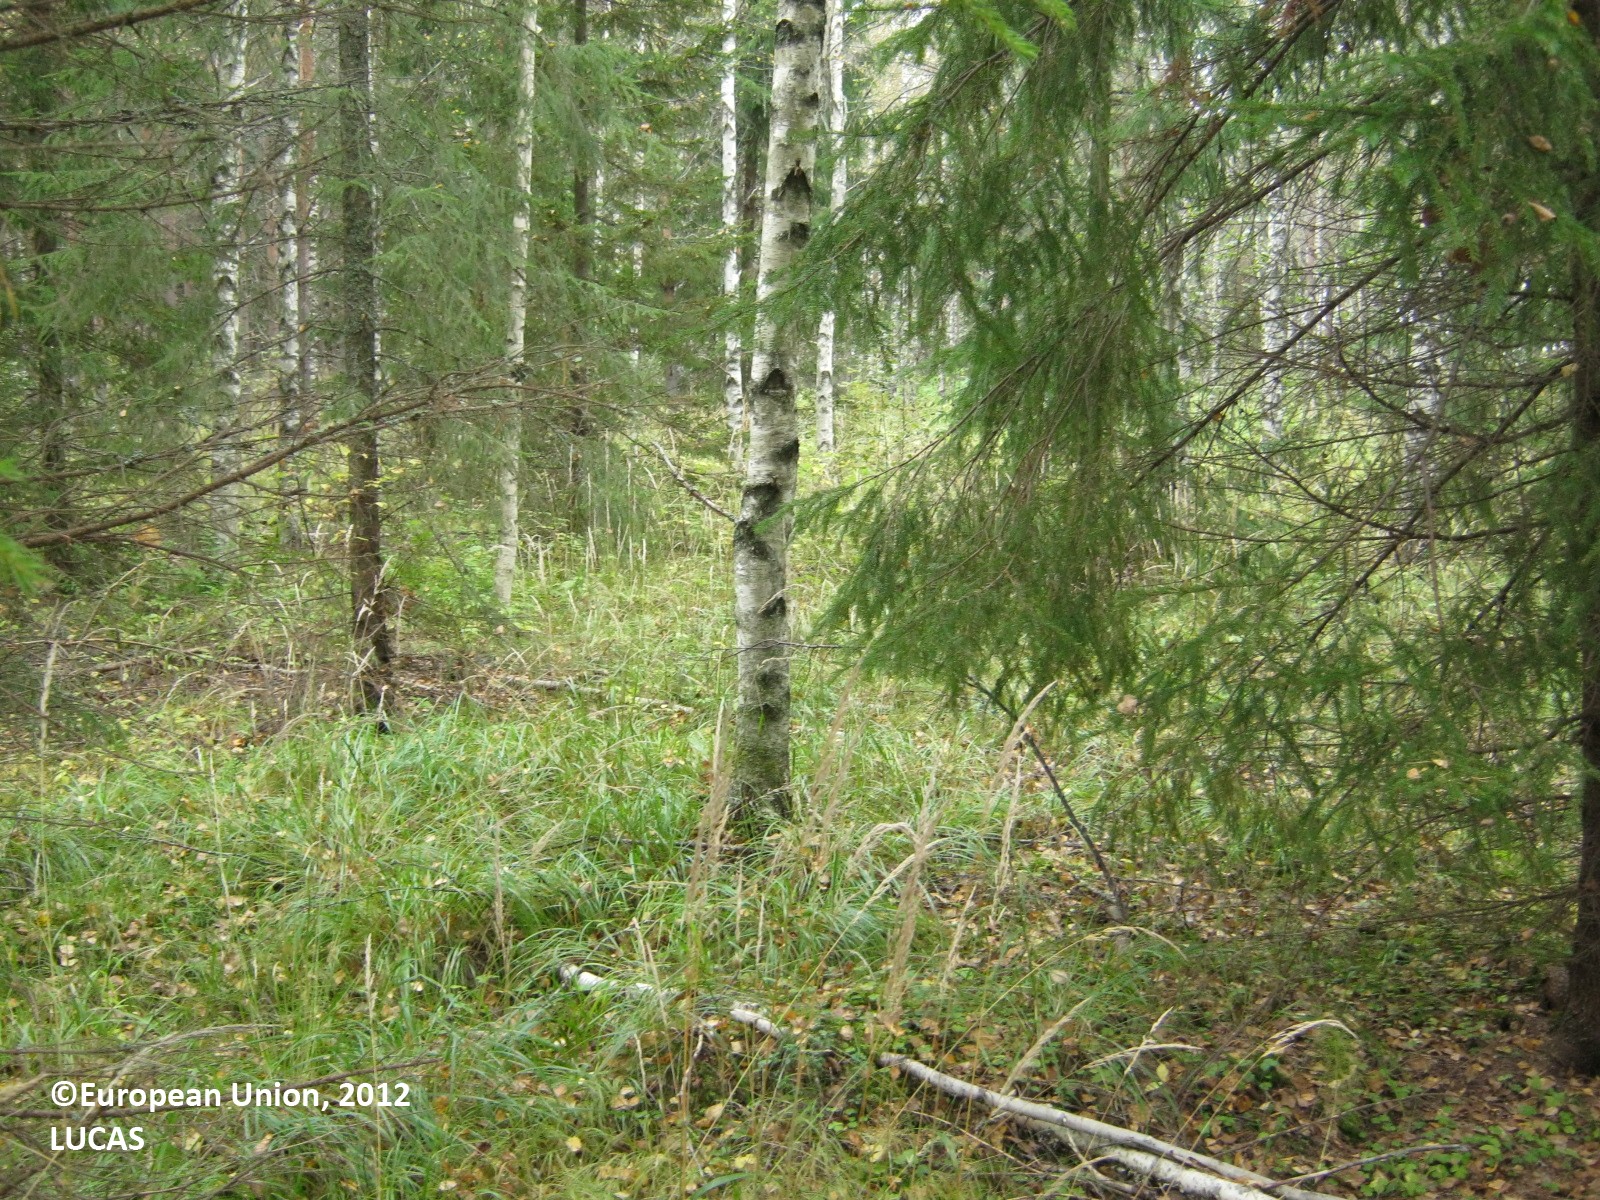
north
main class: Woodland
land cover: Other mixed woodland
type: boreal forest
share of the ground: > 75 %
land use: Forestry
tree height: > 5 m
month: September
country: FI
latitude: 61.0047
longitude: 28.0468
